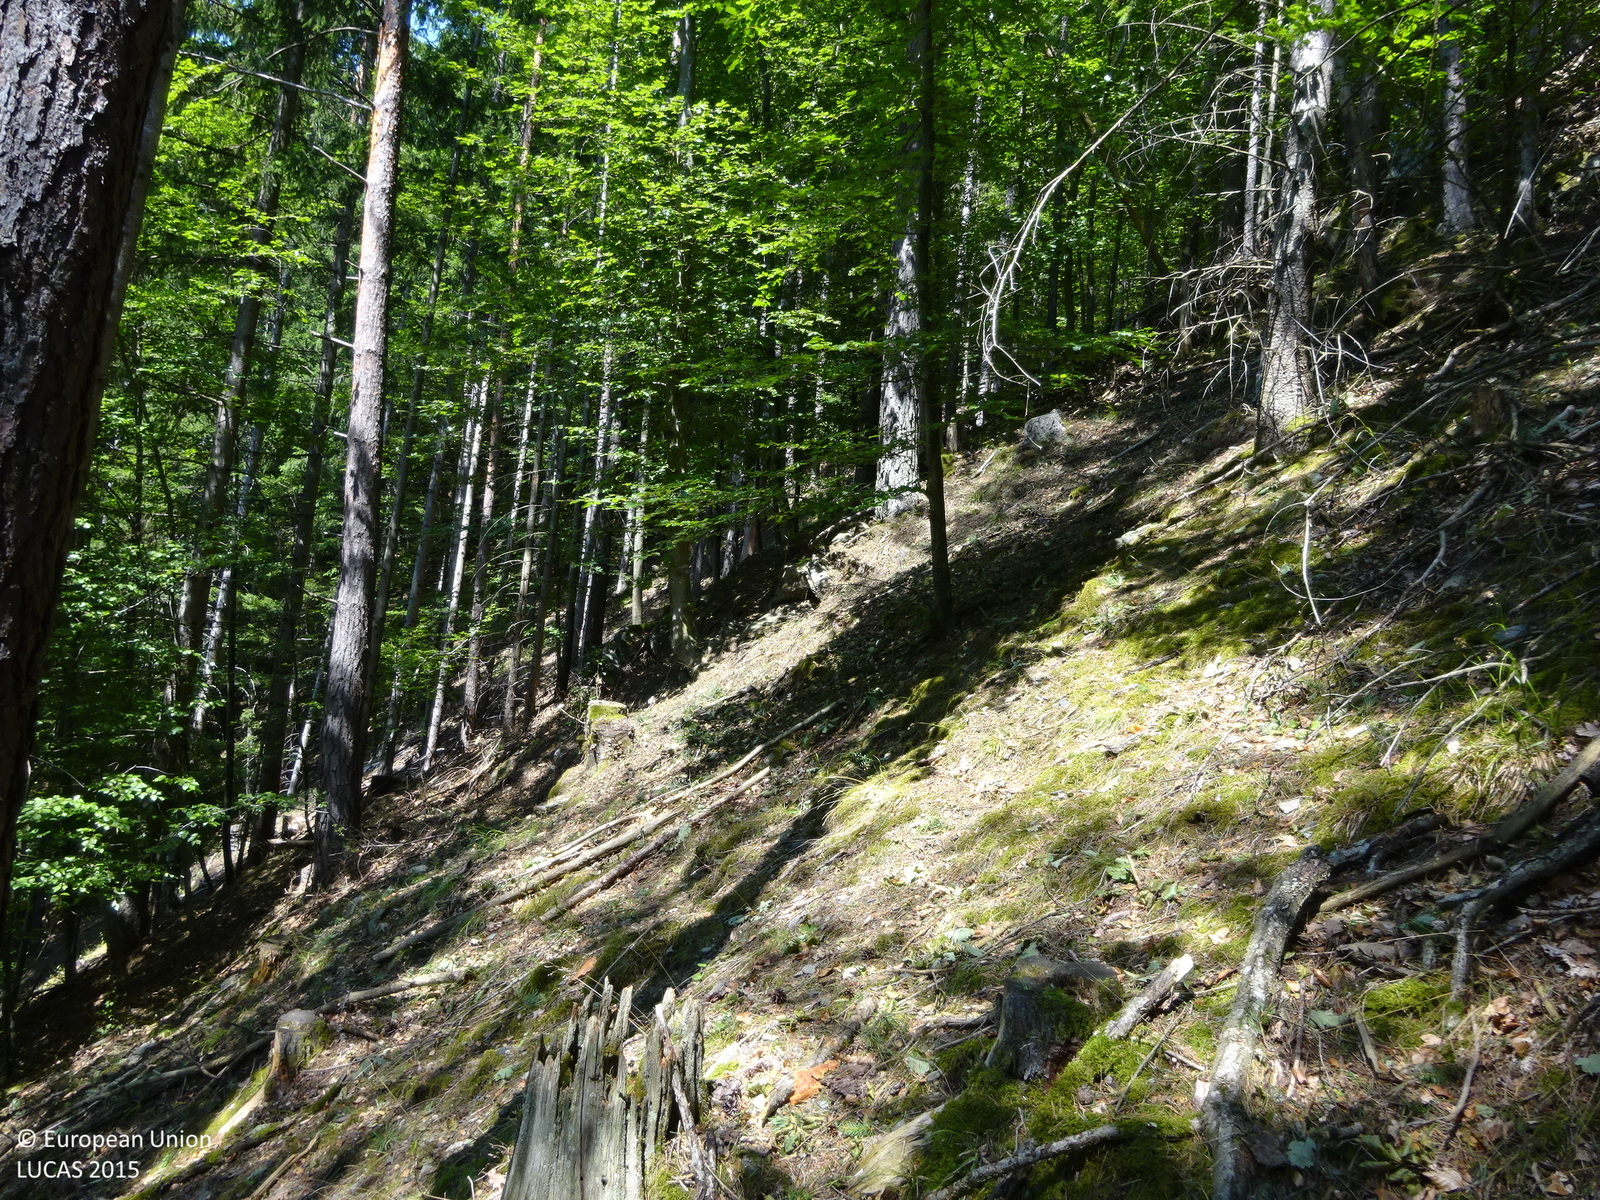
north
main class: Woodland
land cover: Pine dominated mixed woodland
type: hemiboreal forest and nemoral coniferous forest and mixed broadleaved-coniferous forest
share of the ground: > 75 %
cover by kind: coniferous forest trees 45 %, broadleaved forest trees 45 %, lichens and mosses 5 %, unconsolidated bare surface 5 %
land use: Forestry
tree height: > 5 m
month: July
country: AT
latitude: 47.2857
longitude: 15.2754
